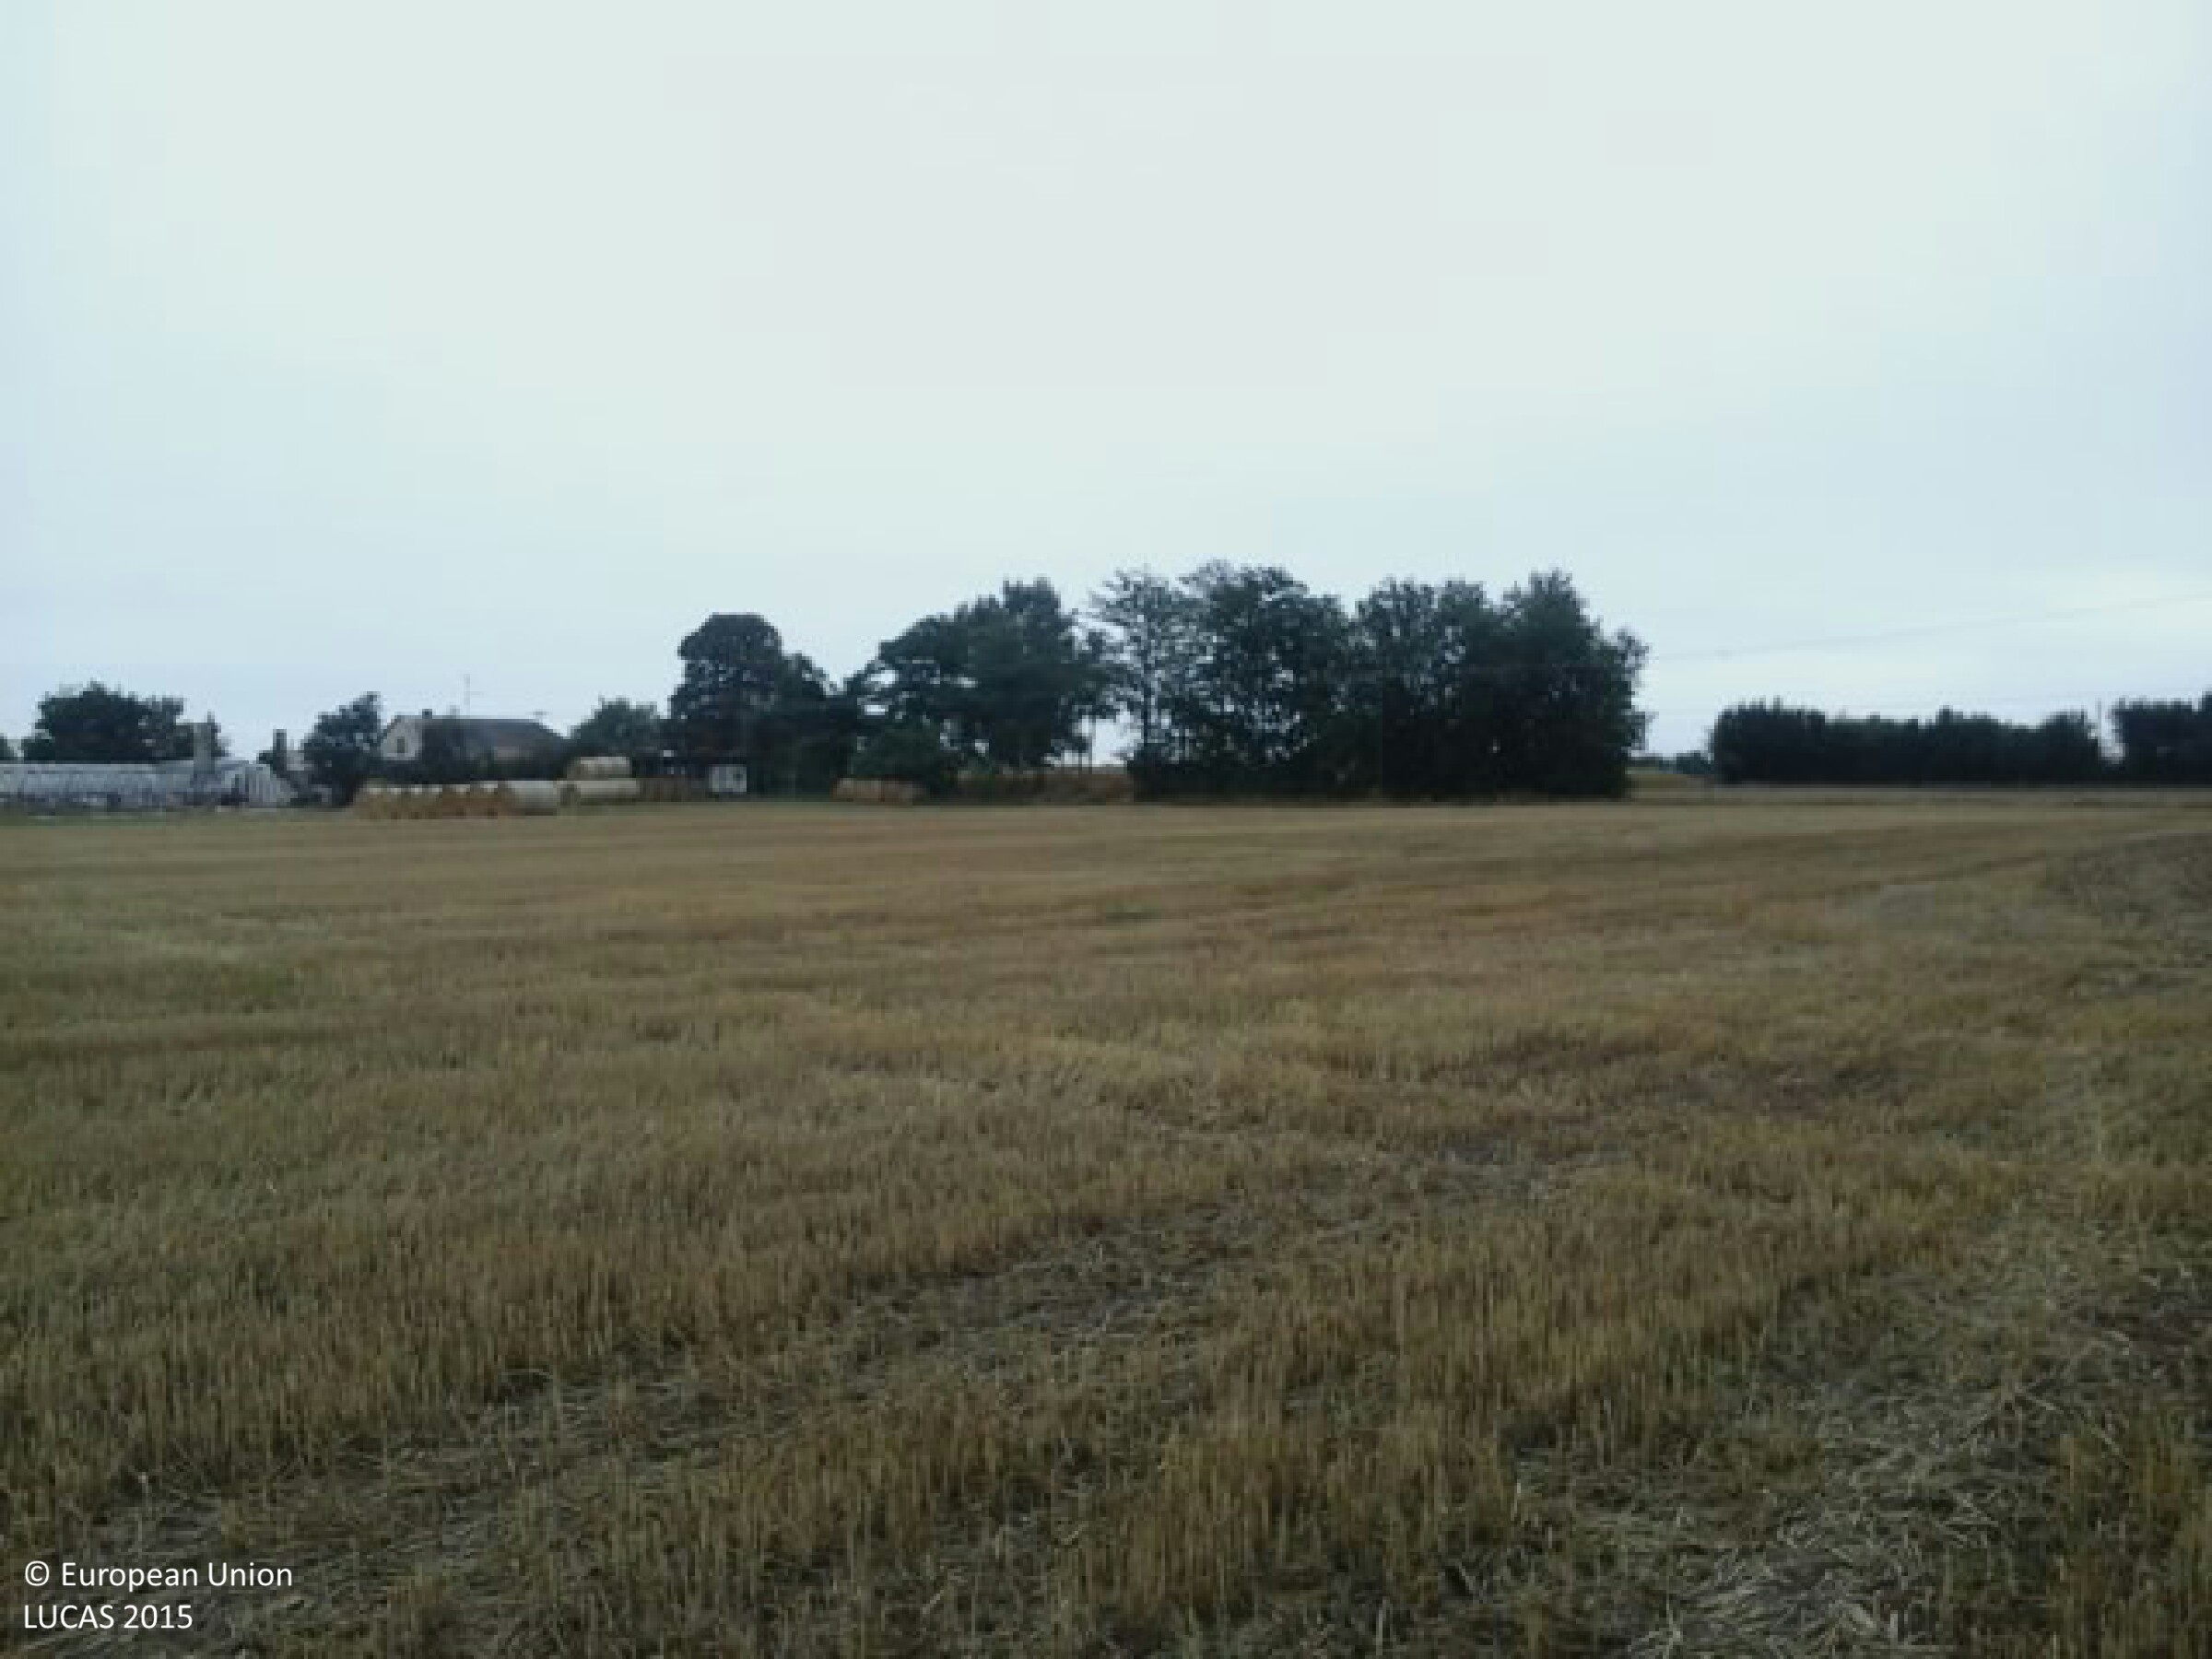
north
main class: Cropland
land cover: Common wheat
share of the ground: 10 - 25 %
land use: Agriculture (excluding fallow land and kitchen gardens)
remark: Harvested field
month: July
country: HU
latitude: 47.0425
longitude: 19.8013
